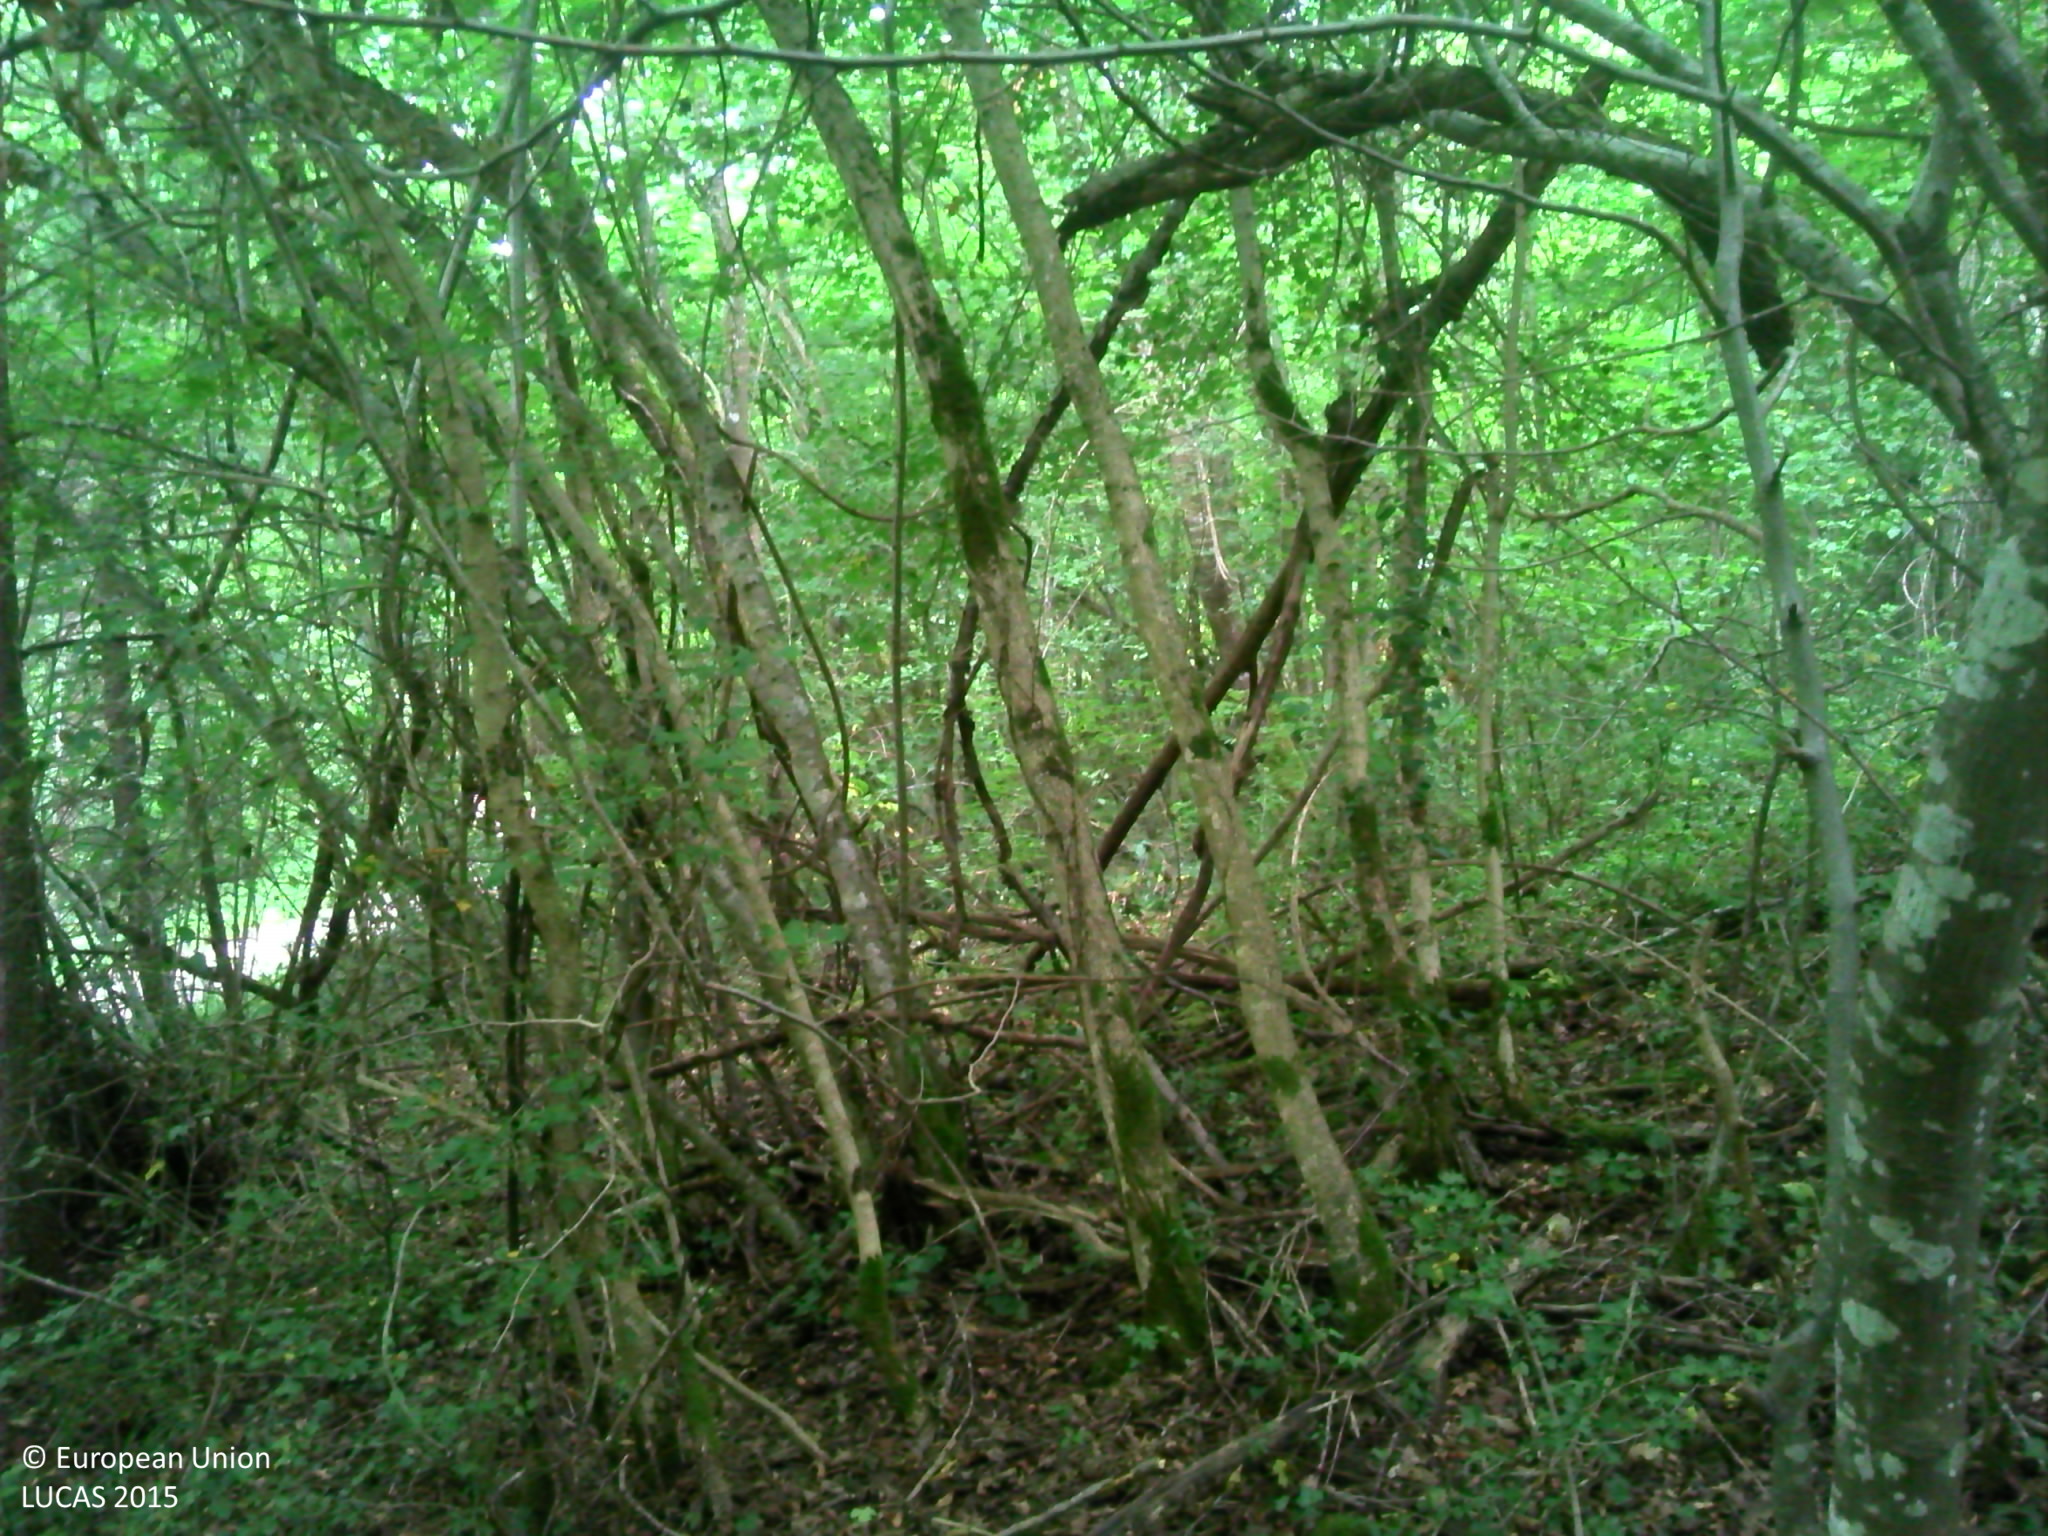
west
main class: Woodland
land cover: Broadleaved woodland
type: beech forest
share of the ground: > 75 %
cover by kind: broadleaved forest trees 100 %
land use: Forestry
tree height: > 5 m
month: July
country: FR
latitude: 43.2917
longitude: 0.8438
